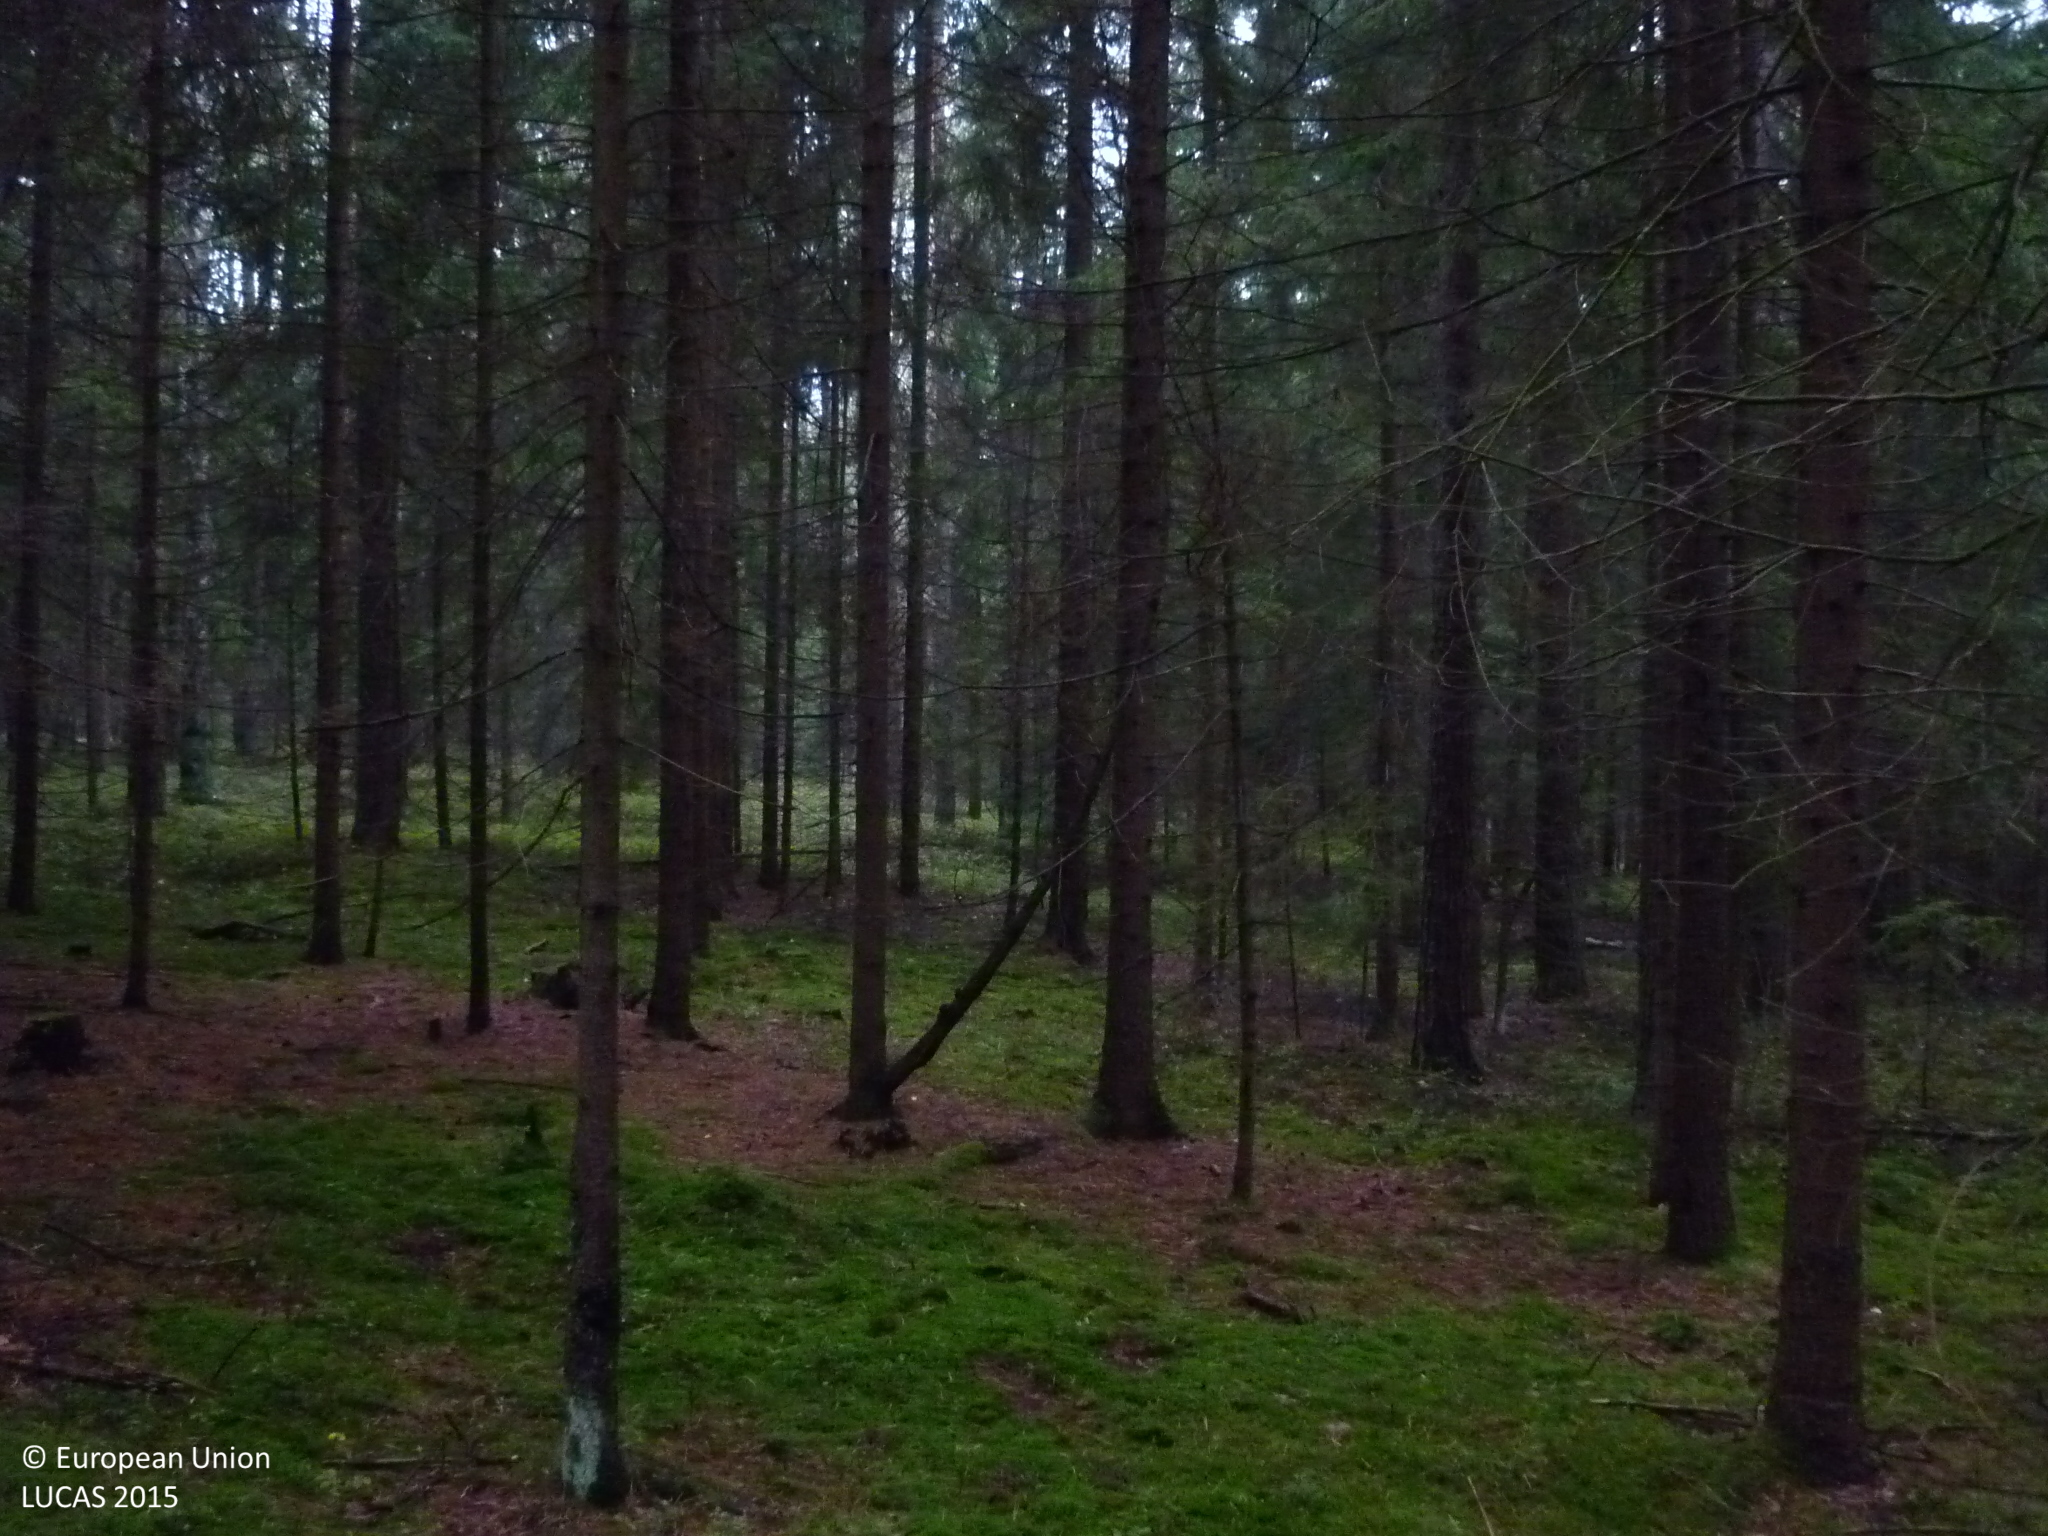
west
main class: Woodland
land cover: Spruce dominated coniferous woodland
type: hemiboreal forest and nemoral coniferous forest and mixed broadleaved-coniferous forest
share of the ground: > 75 %
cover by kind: coniferous forest trees 90 %, lichens and mosses 10 %
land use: Forestry
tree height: > 5 m
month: September
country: AT
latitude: 48.9184
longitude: 15.0650
